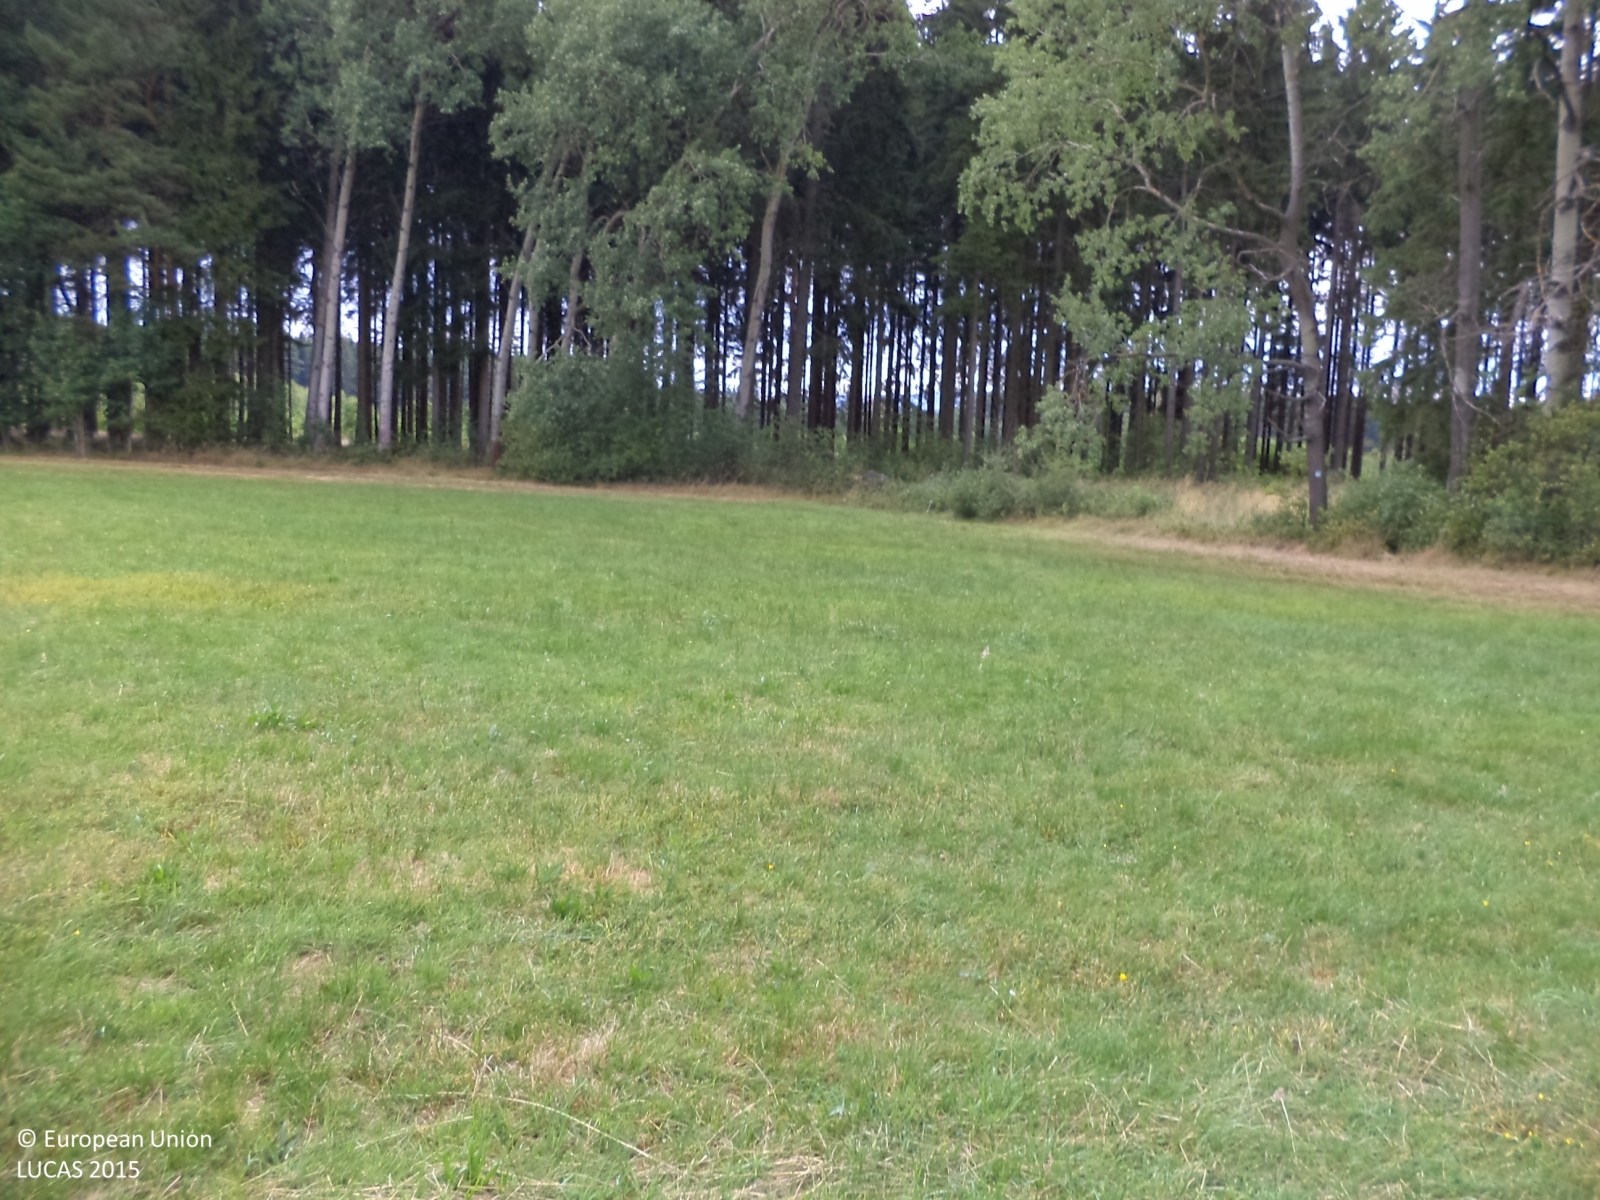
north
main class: Grassland
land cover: Grassland without tree/shrub cover
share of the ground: > 75 %
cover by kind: herbaceous plants 100 %
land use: Agriculture (excluding fallow land and kitchen gardens)
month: July
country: CZ
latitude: 49.5987
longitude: 13.8054
